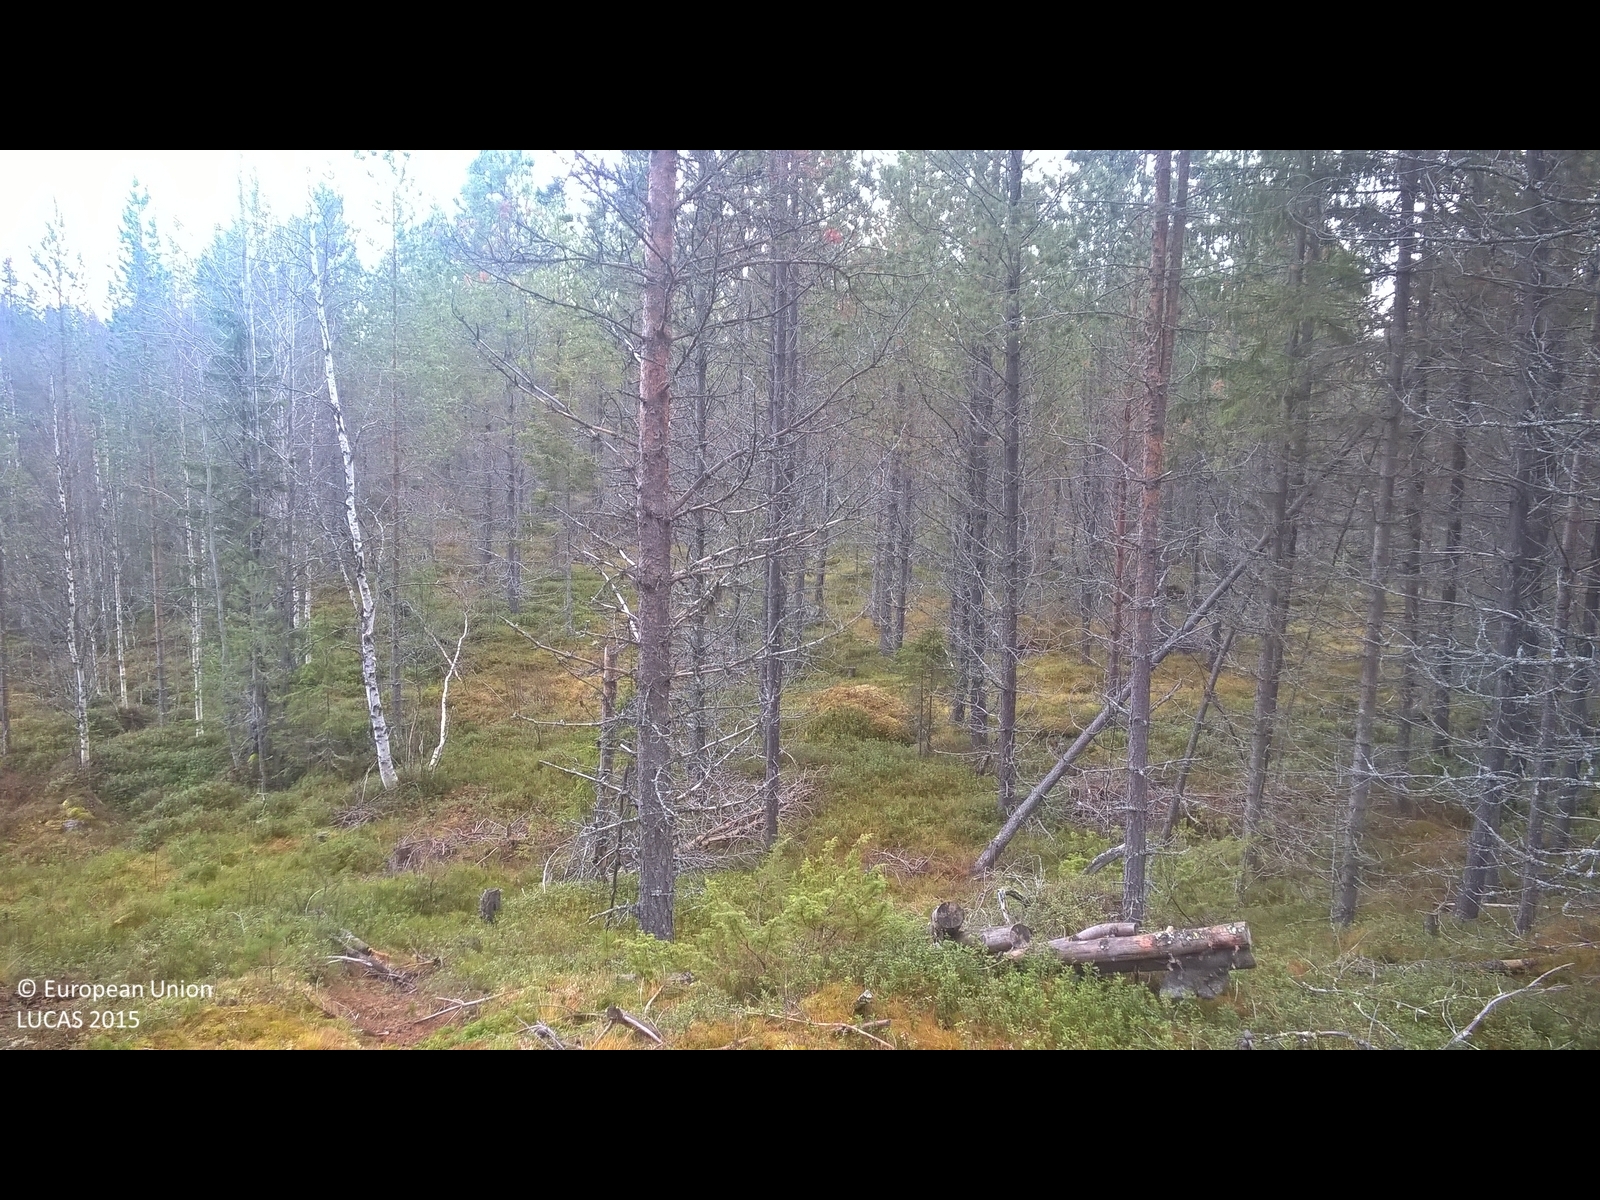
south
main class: Shrubland
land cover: Shrubland without tree cover
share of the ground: > 75 %
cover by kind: shrubs 50 %, herbaceous plants 50 %
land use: Electricity, gas and thermal power distribution
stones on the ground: < 10 %
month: October
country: SE
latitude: 65.2011
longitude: 17.8893
